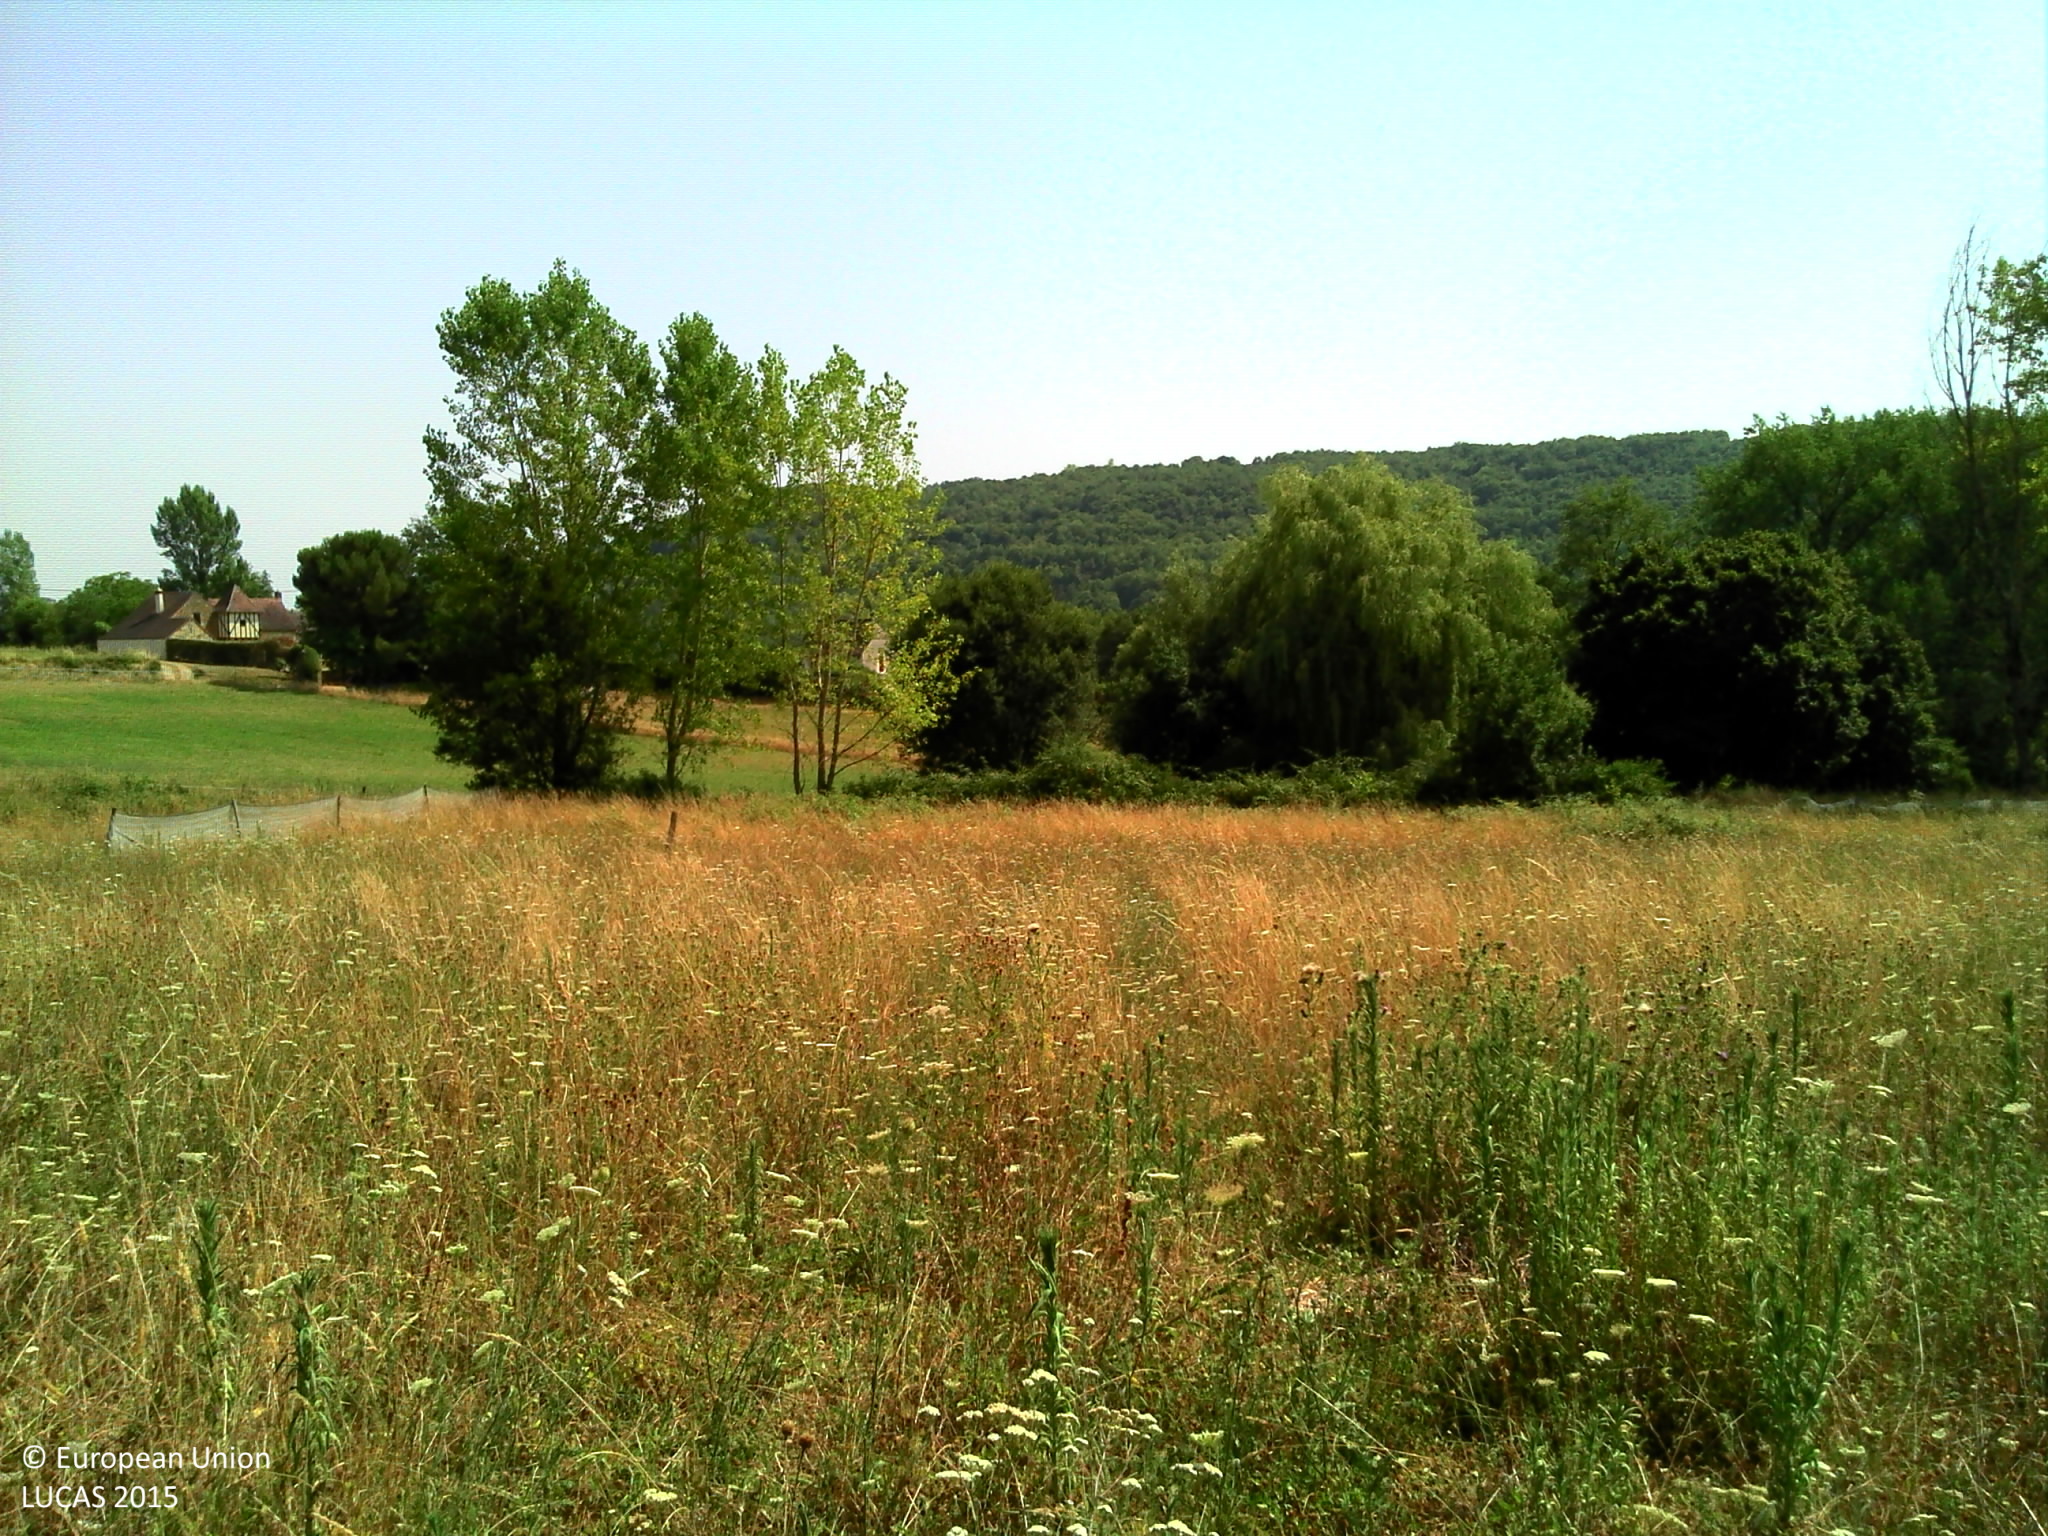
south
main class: Grassland
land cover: Grassland without tree/shrub cover
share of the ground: > 75 %
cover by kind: herbaceous plants 100 %
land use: Agriculture (excluding fallow land and kitchen gardens)
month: July
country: FR
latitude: 45.1527
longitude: 1.1785
